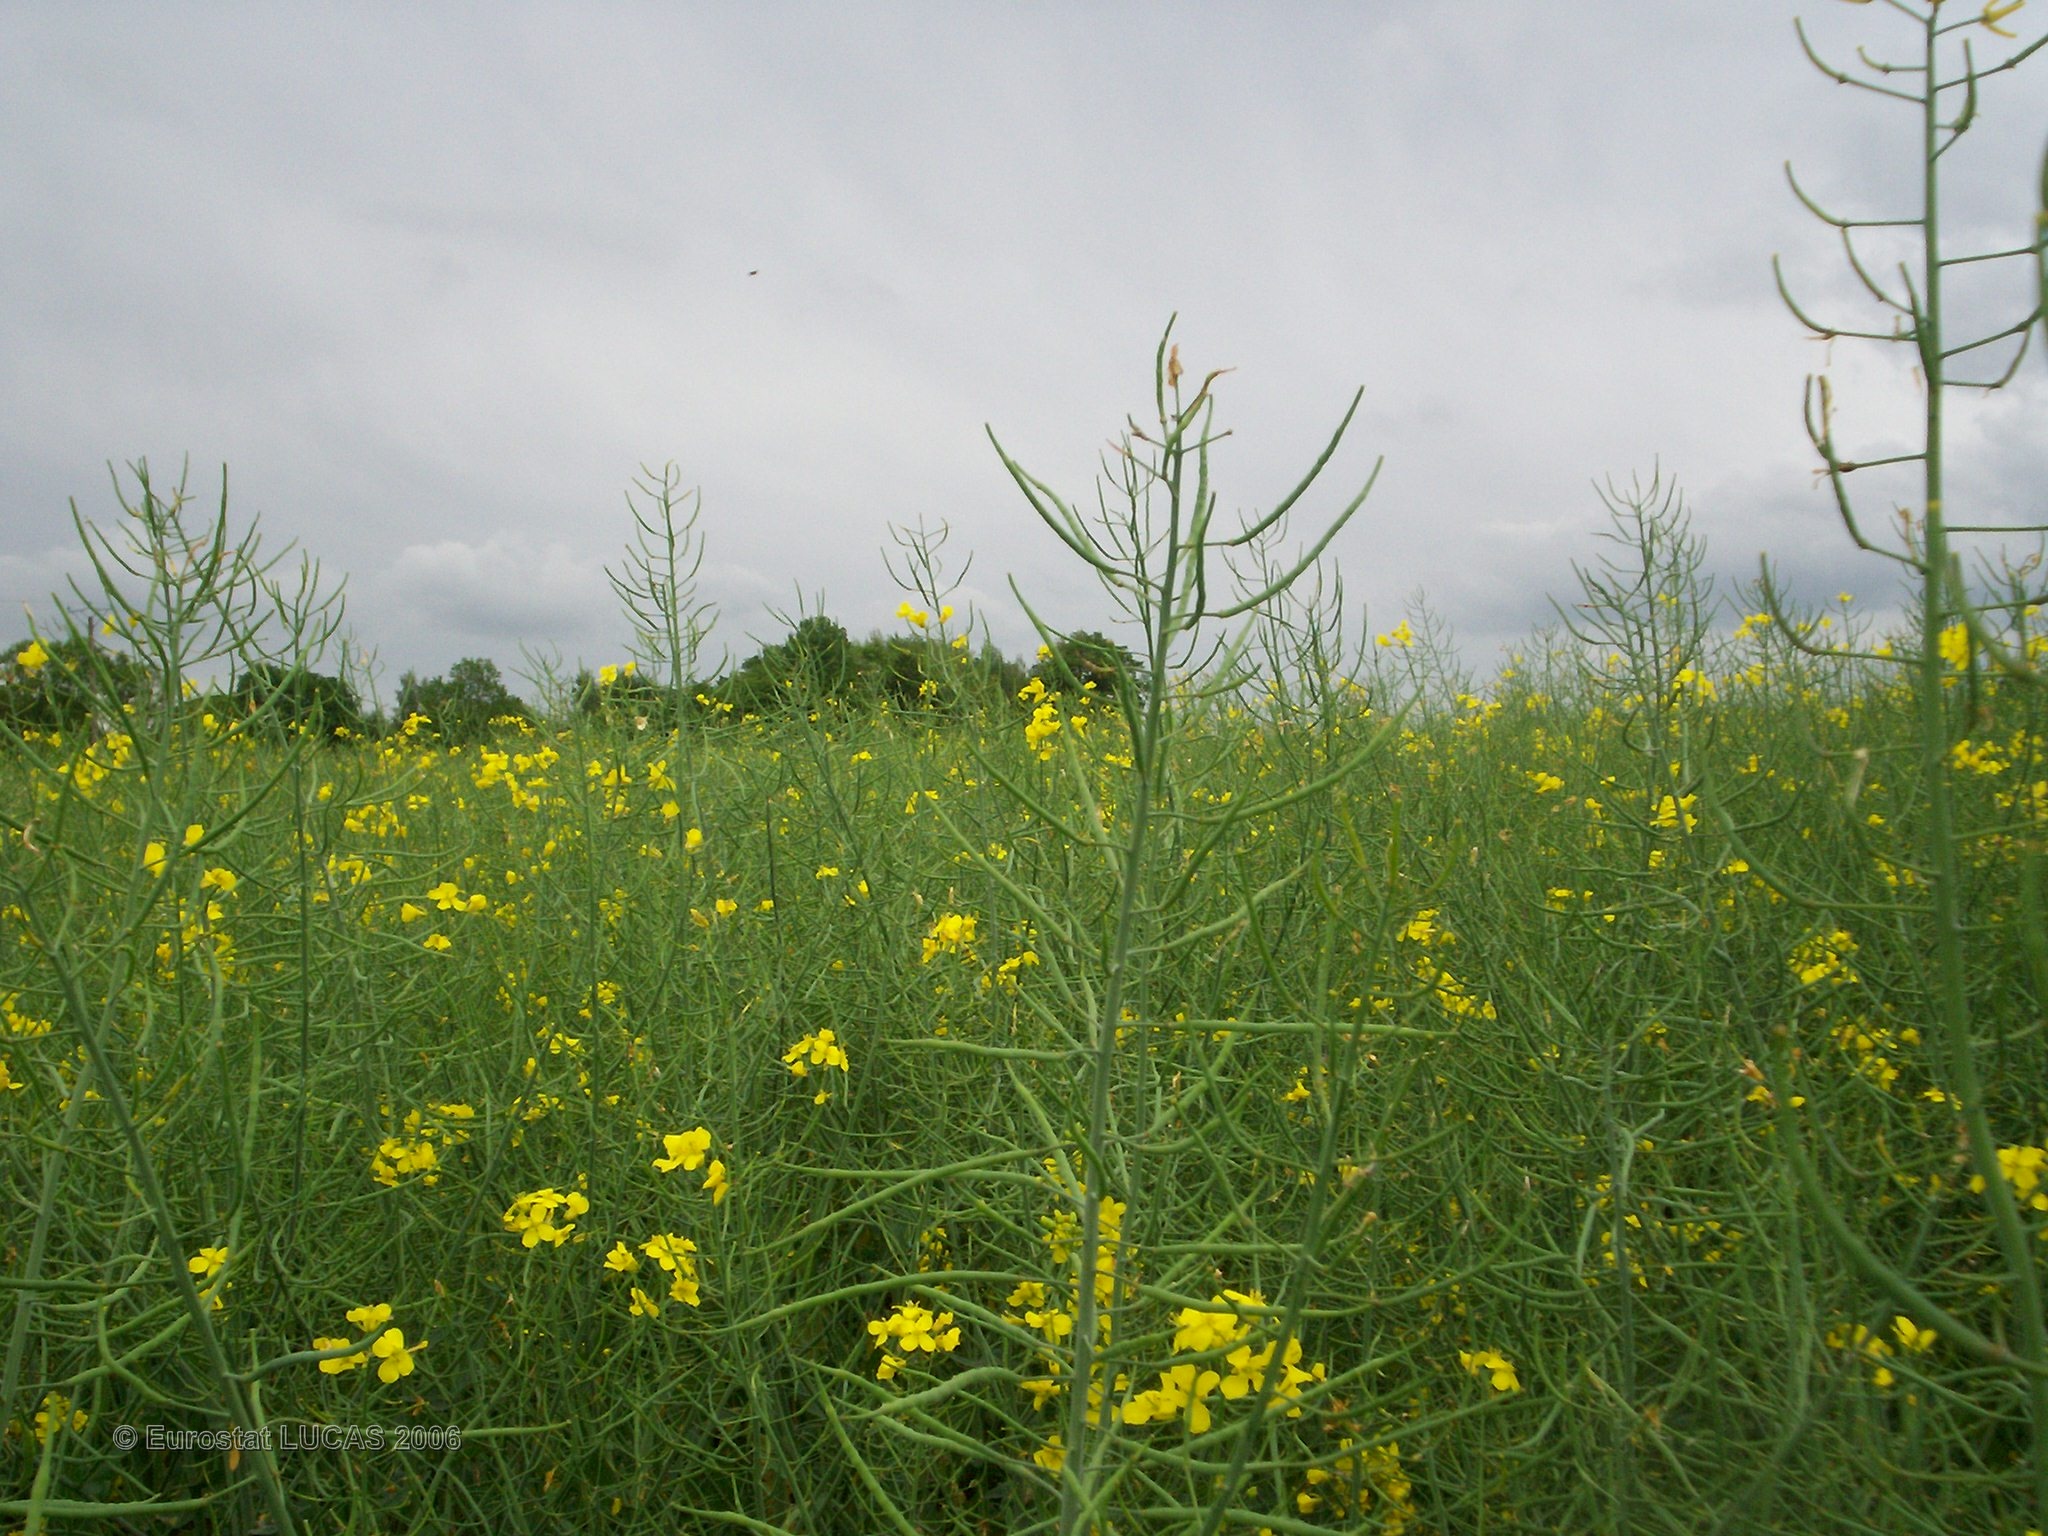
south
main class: Cropland
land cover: Rape and turnip rape
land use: Agriculture (excluding fallow land and kitchen gardens)
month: May
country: FR
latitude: 47.7995
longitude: 2.9572
